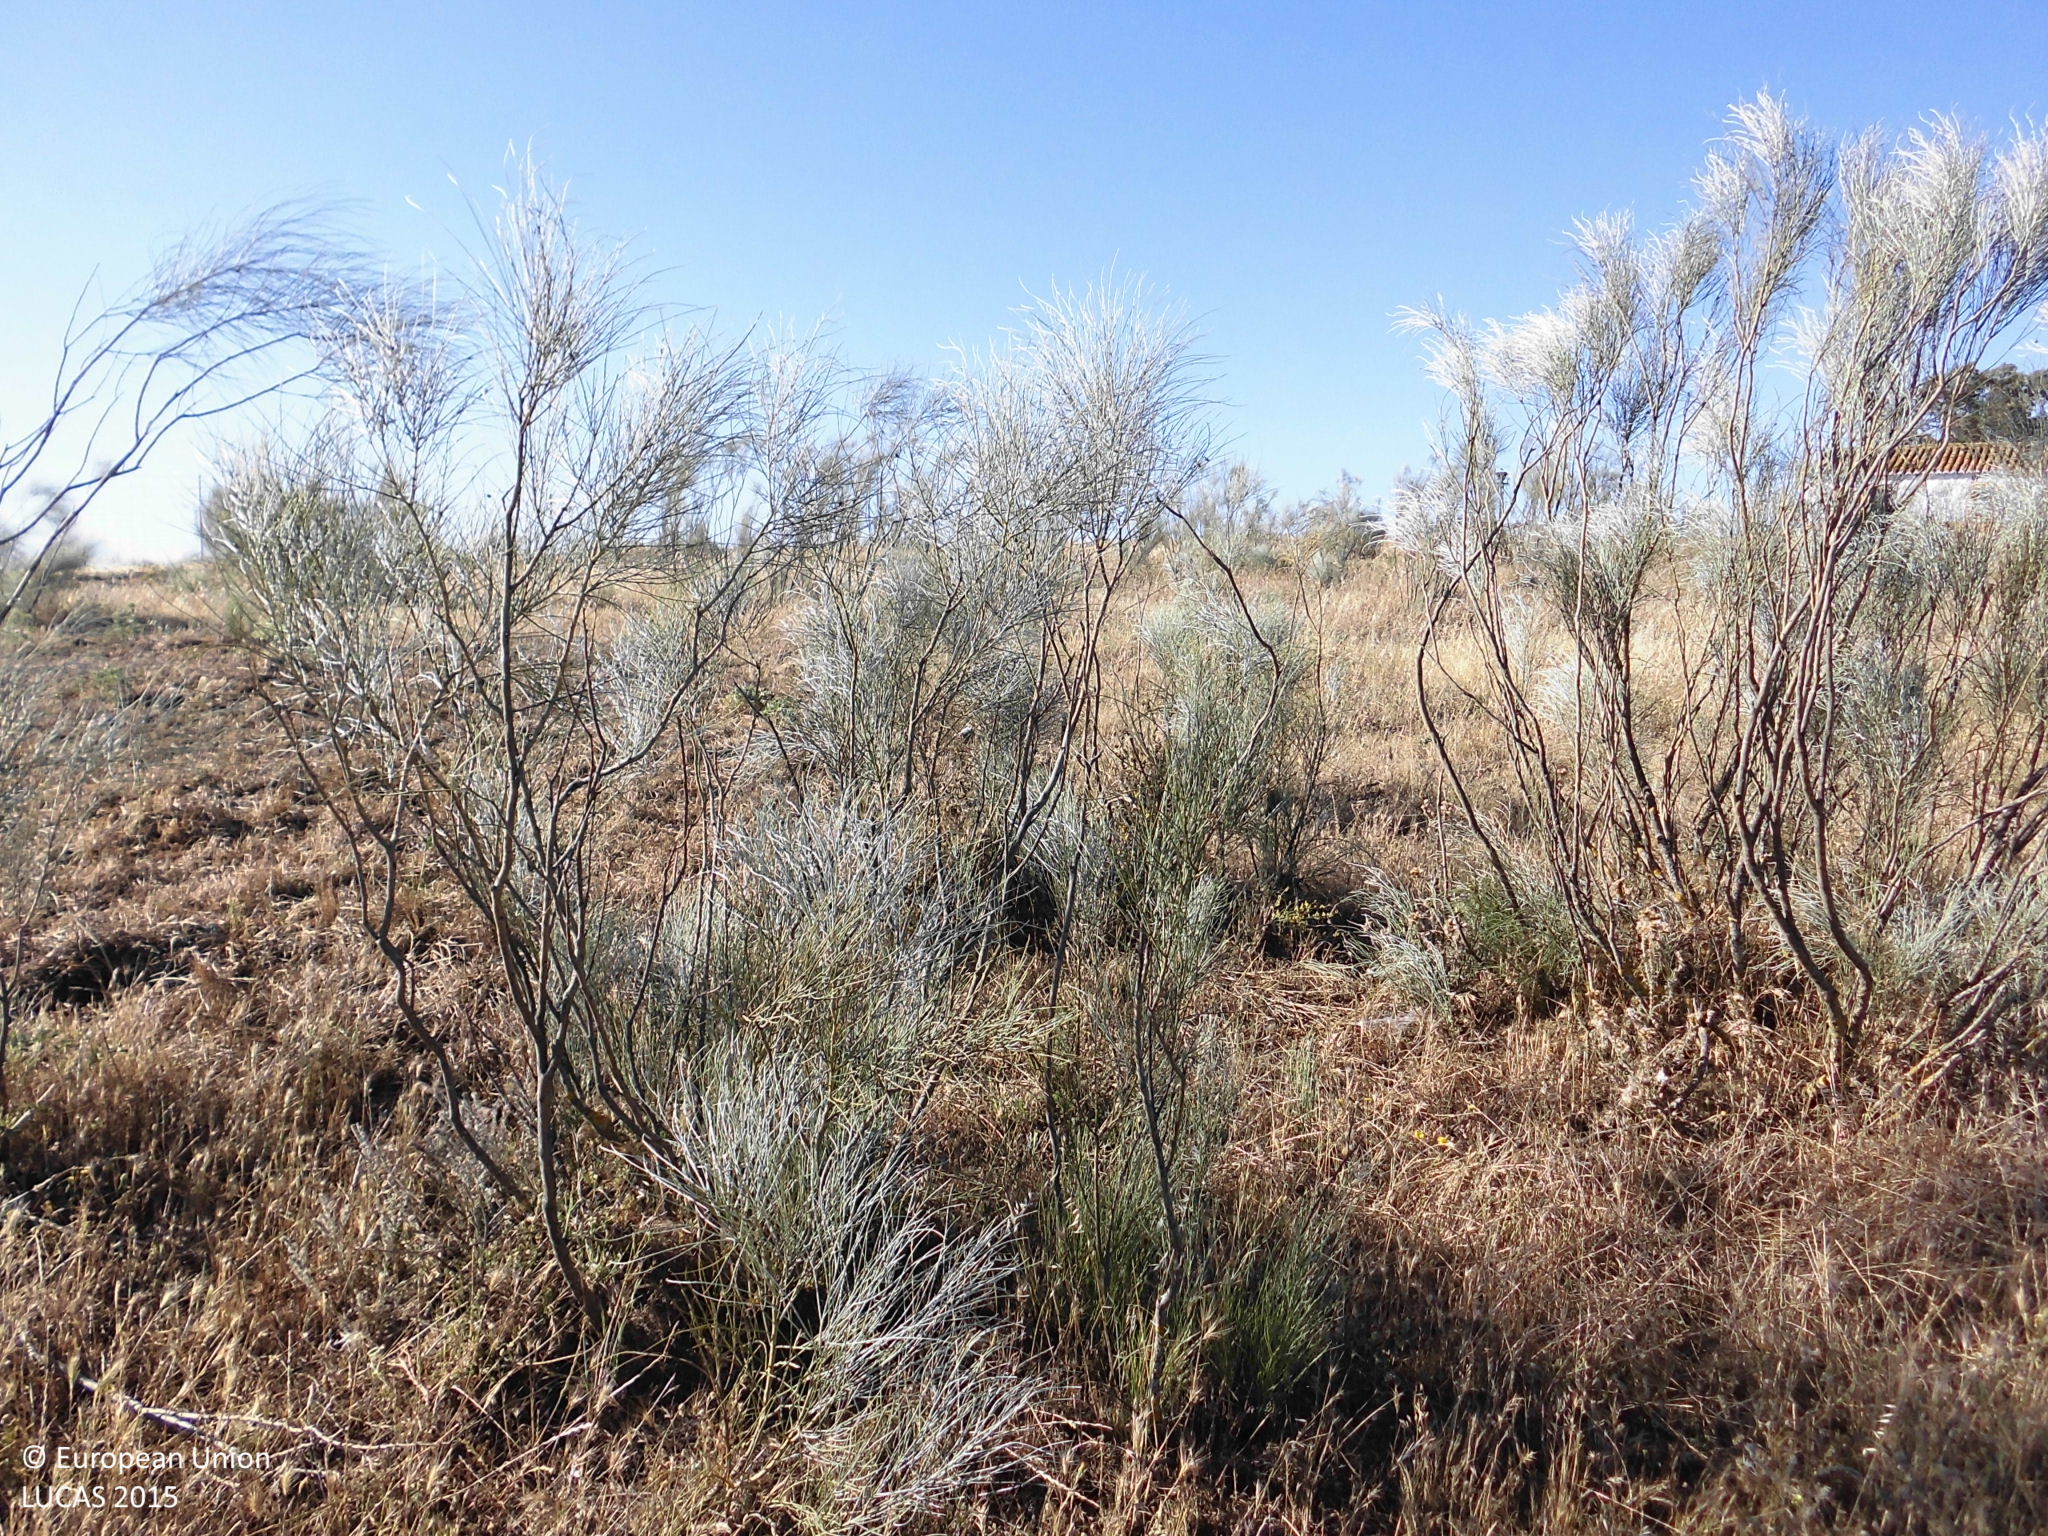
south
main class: Shrubland
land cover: Shrubland without tree cover
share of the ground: 10 - 25 %
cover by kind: herbaceous plants 75 %, shrubs 25 %
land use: Agriculture (excluding fallow land and kitchen gardens)
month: May
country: ES
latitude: 39.5300
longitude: -6.9861
